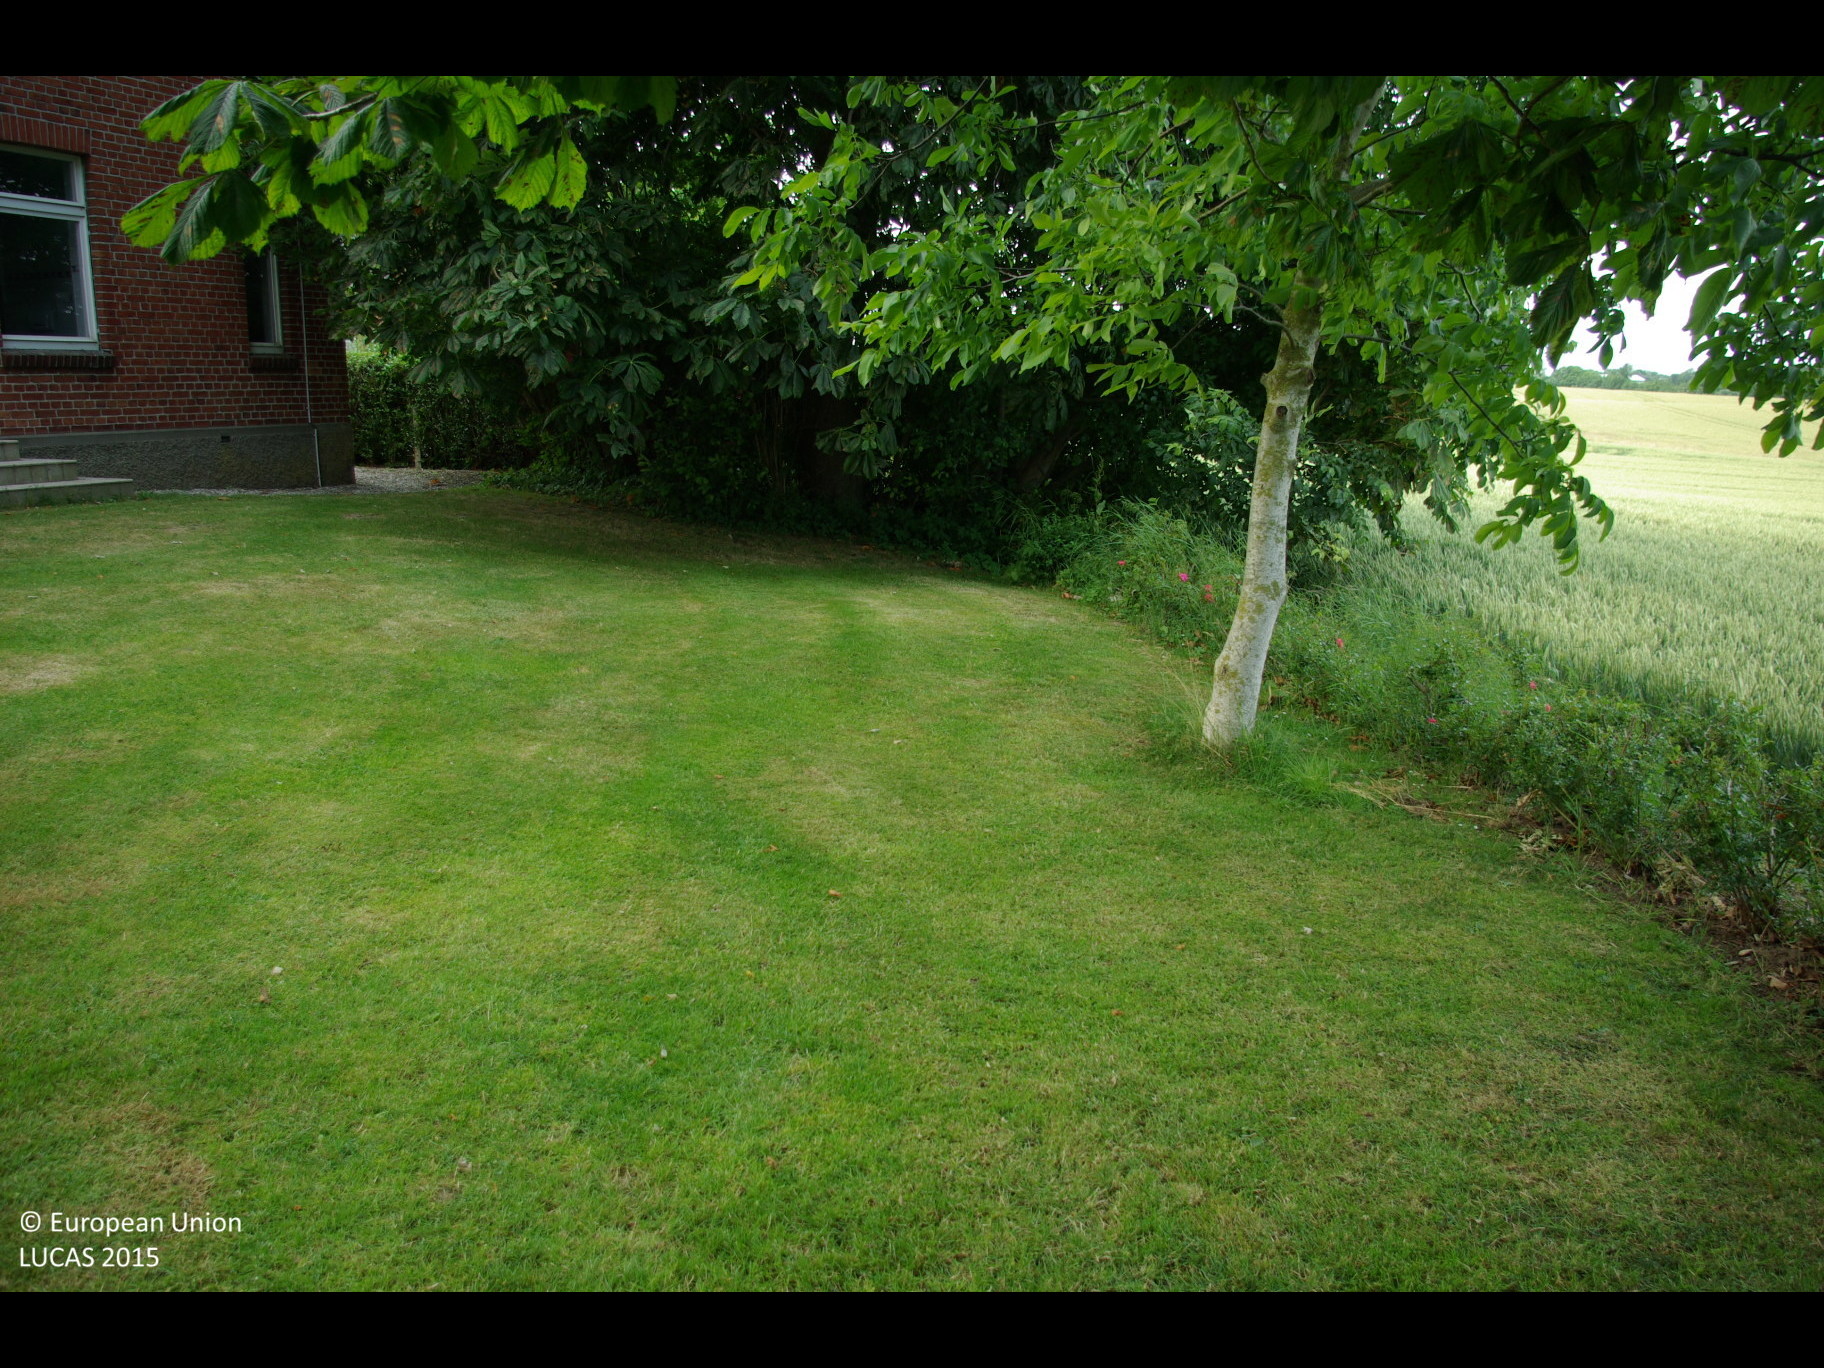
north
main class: Woodland
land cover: Broadleaved woodland
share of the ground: 50 - 75 %
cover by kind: broadleaved forest trees 50 %, herbaceous plants 50 %
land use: Residential
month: July
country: DE
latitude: 54.6779
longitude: 9.9225
